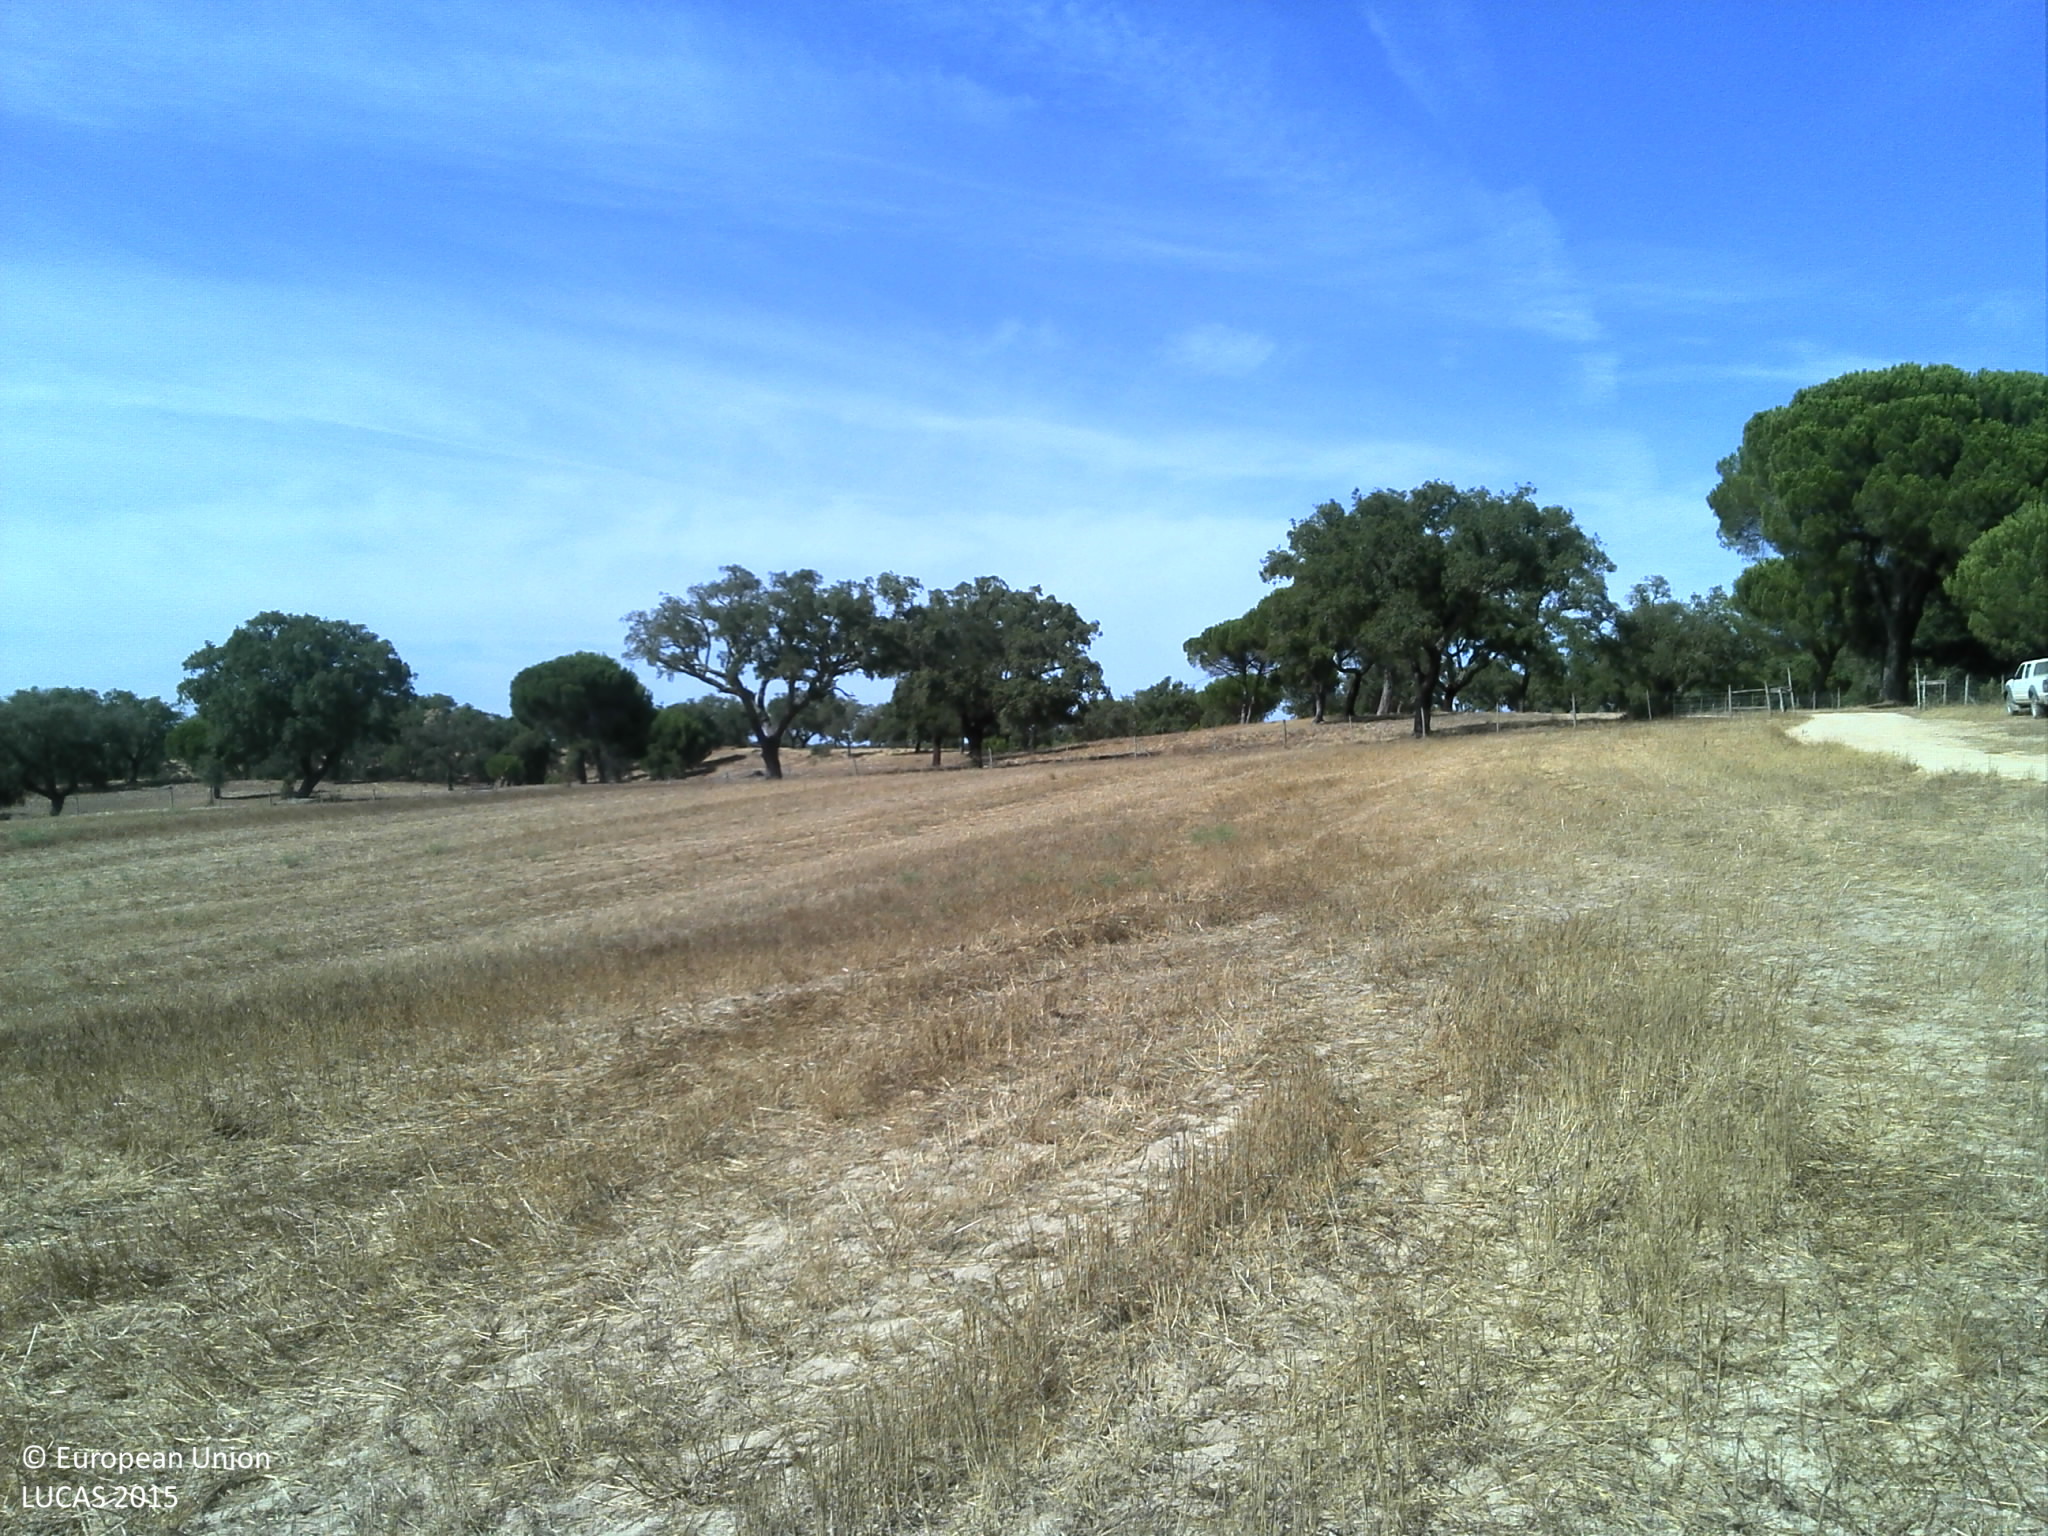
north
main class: Cropland
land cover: Common wheat
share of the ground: < 10 %
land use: Agriculture (excluding fallow land and kitchen gardens)
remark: Harvested field
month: August
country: PT
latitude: 38.7229
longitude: -8.5422
